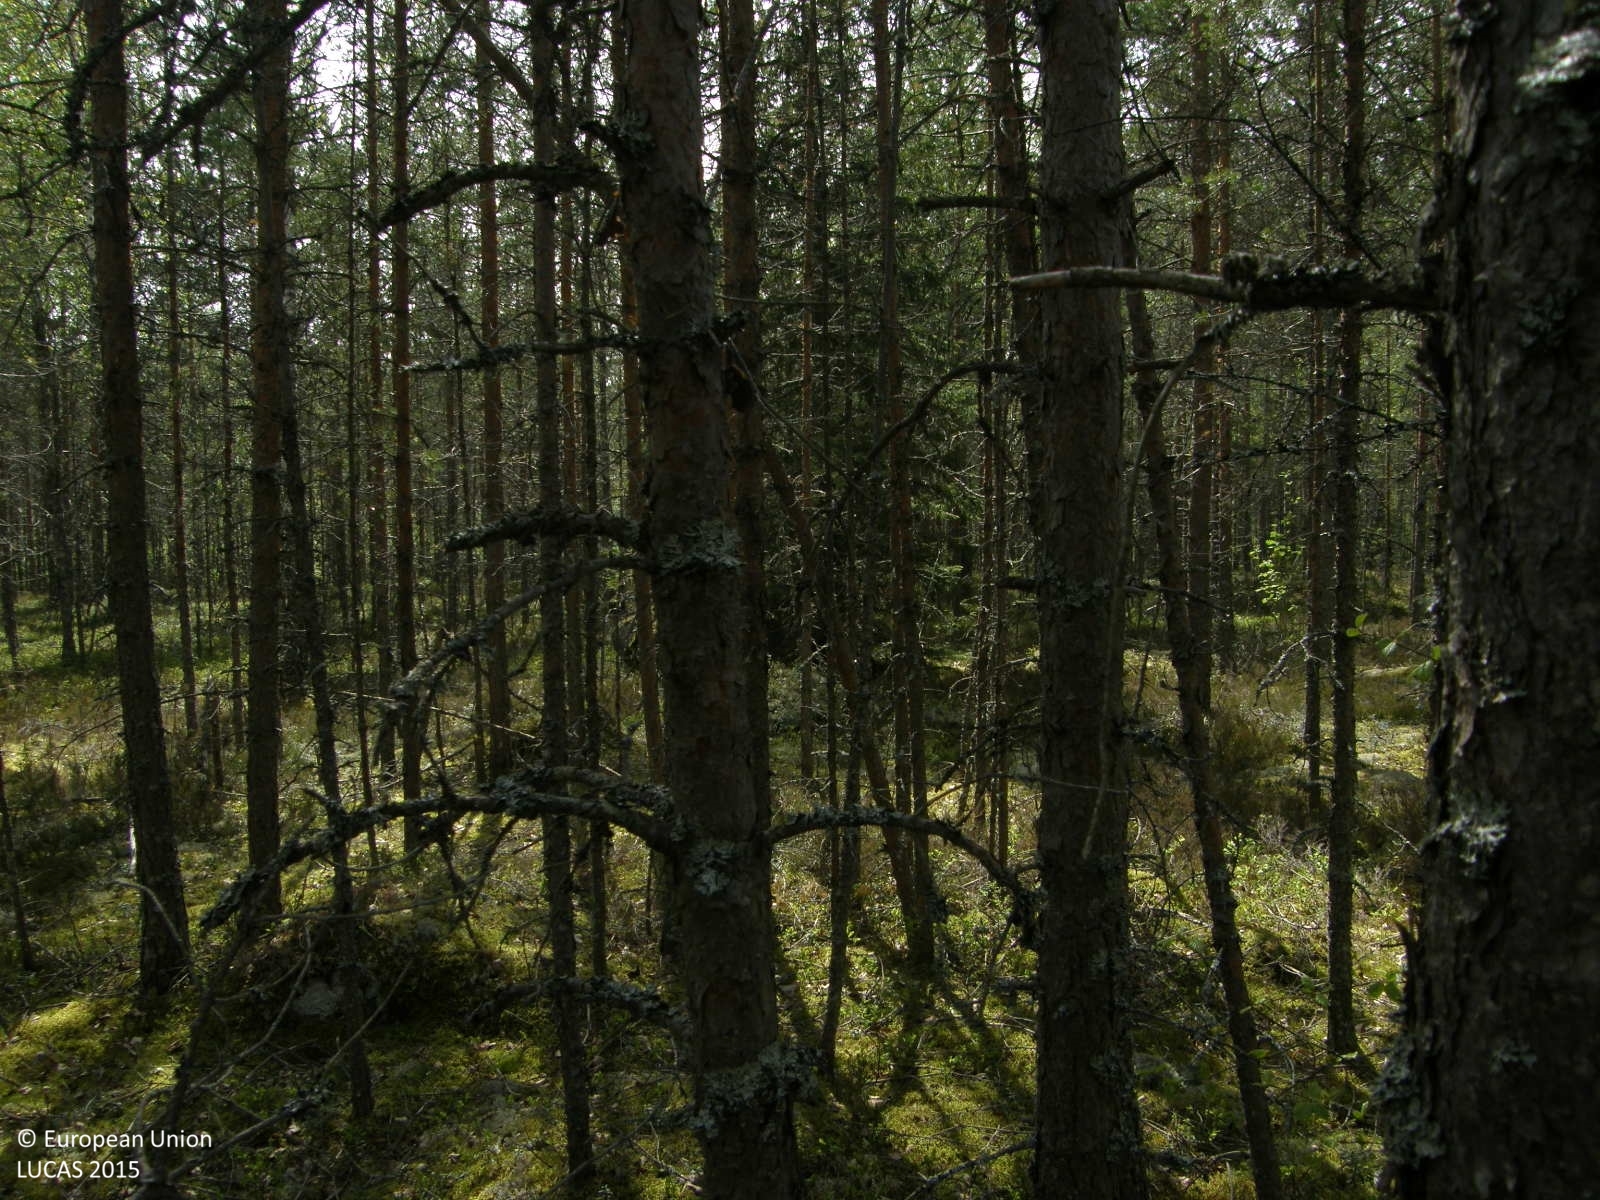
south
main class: Woodland
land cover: Pine dominated coniferous woodland
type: boreal forest
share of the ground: > 75 %
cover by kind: coniferous forest trees 90 %, broadleaved forest trees 5 %, lichens and mosses 5 %
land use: Forestry
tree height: > 5 m
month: June
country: FI
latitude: 62.1382
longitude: 22.3514
